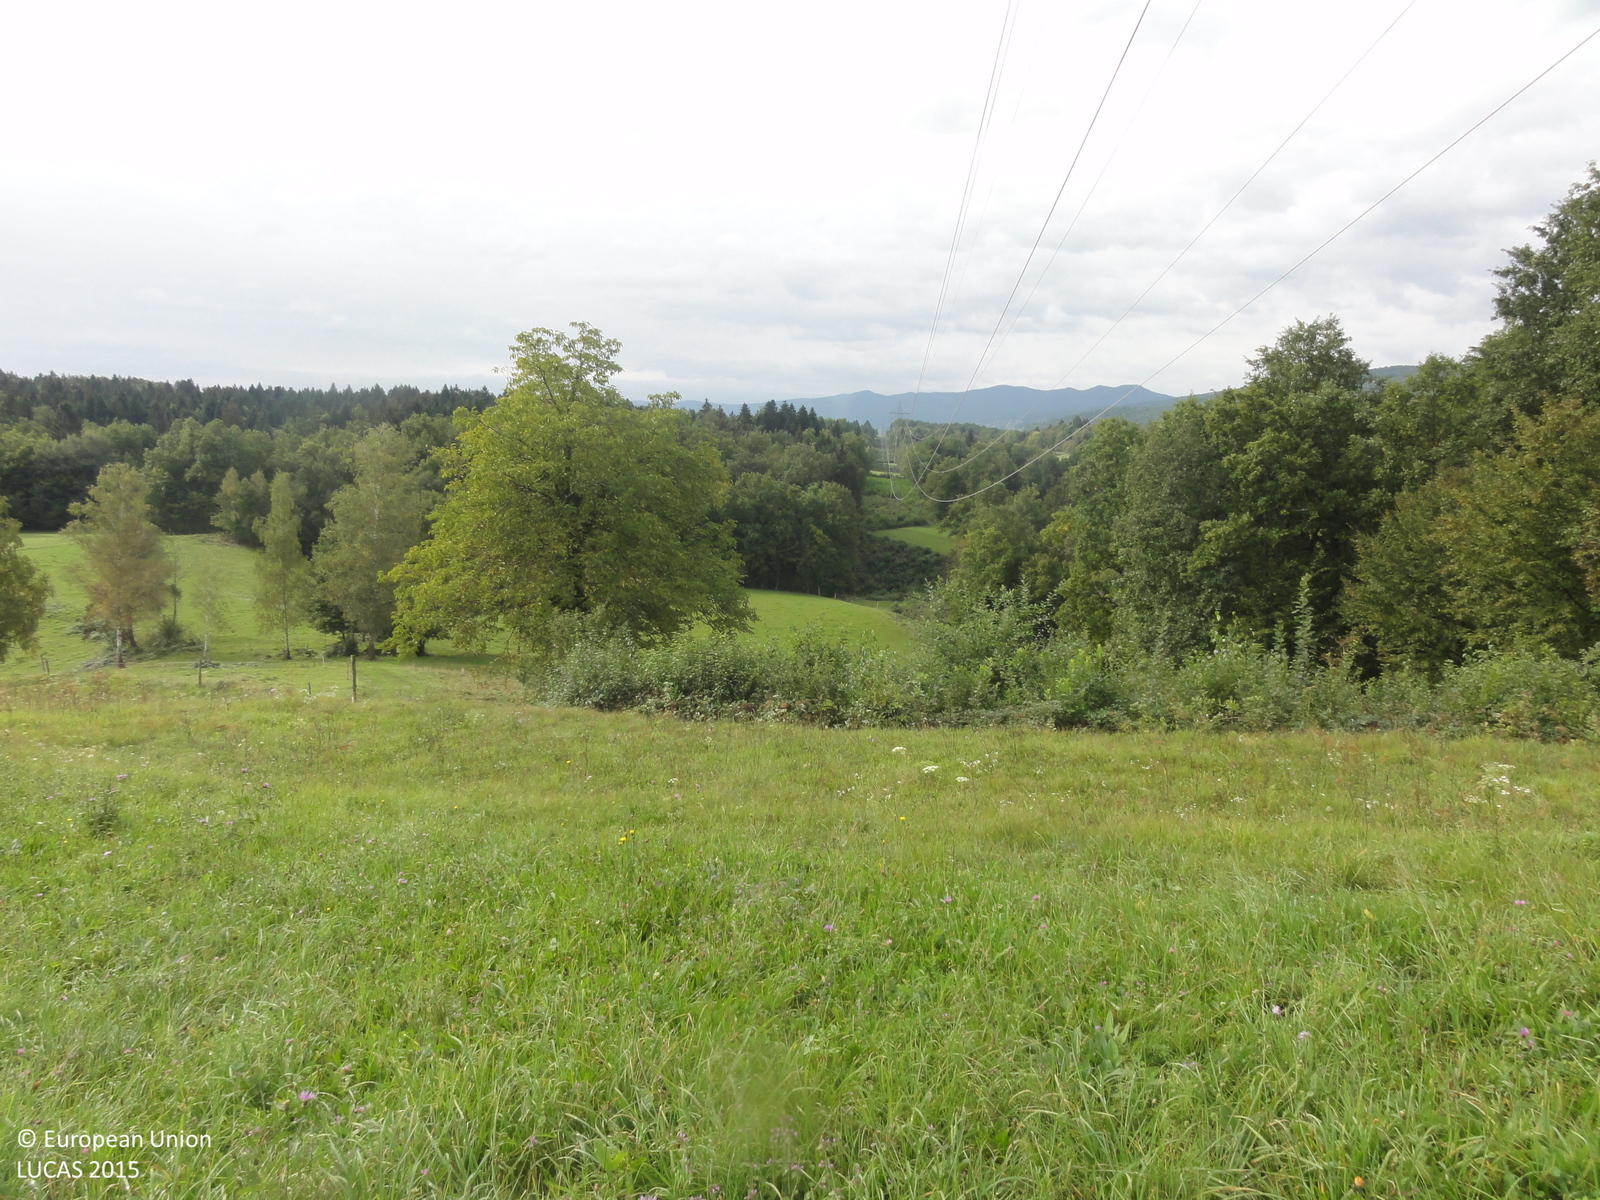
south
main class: Artificial land
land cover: Other artificial areas
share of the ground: 10 - 25 %
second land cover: Grassland without tree/shrub cover
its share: > 75 %
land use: Electricity, gas and thermal power distribution
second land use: Agriculture (excluding fallow land and kitchen gardens)
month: September
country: SI
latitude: 45.6295
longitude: 15.1911
